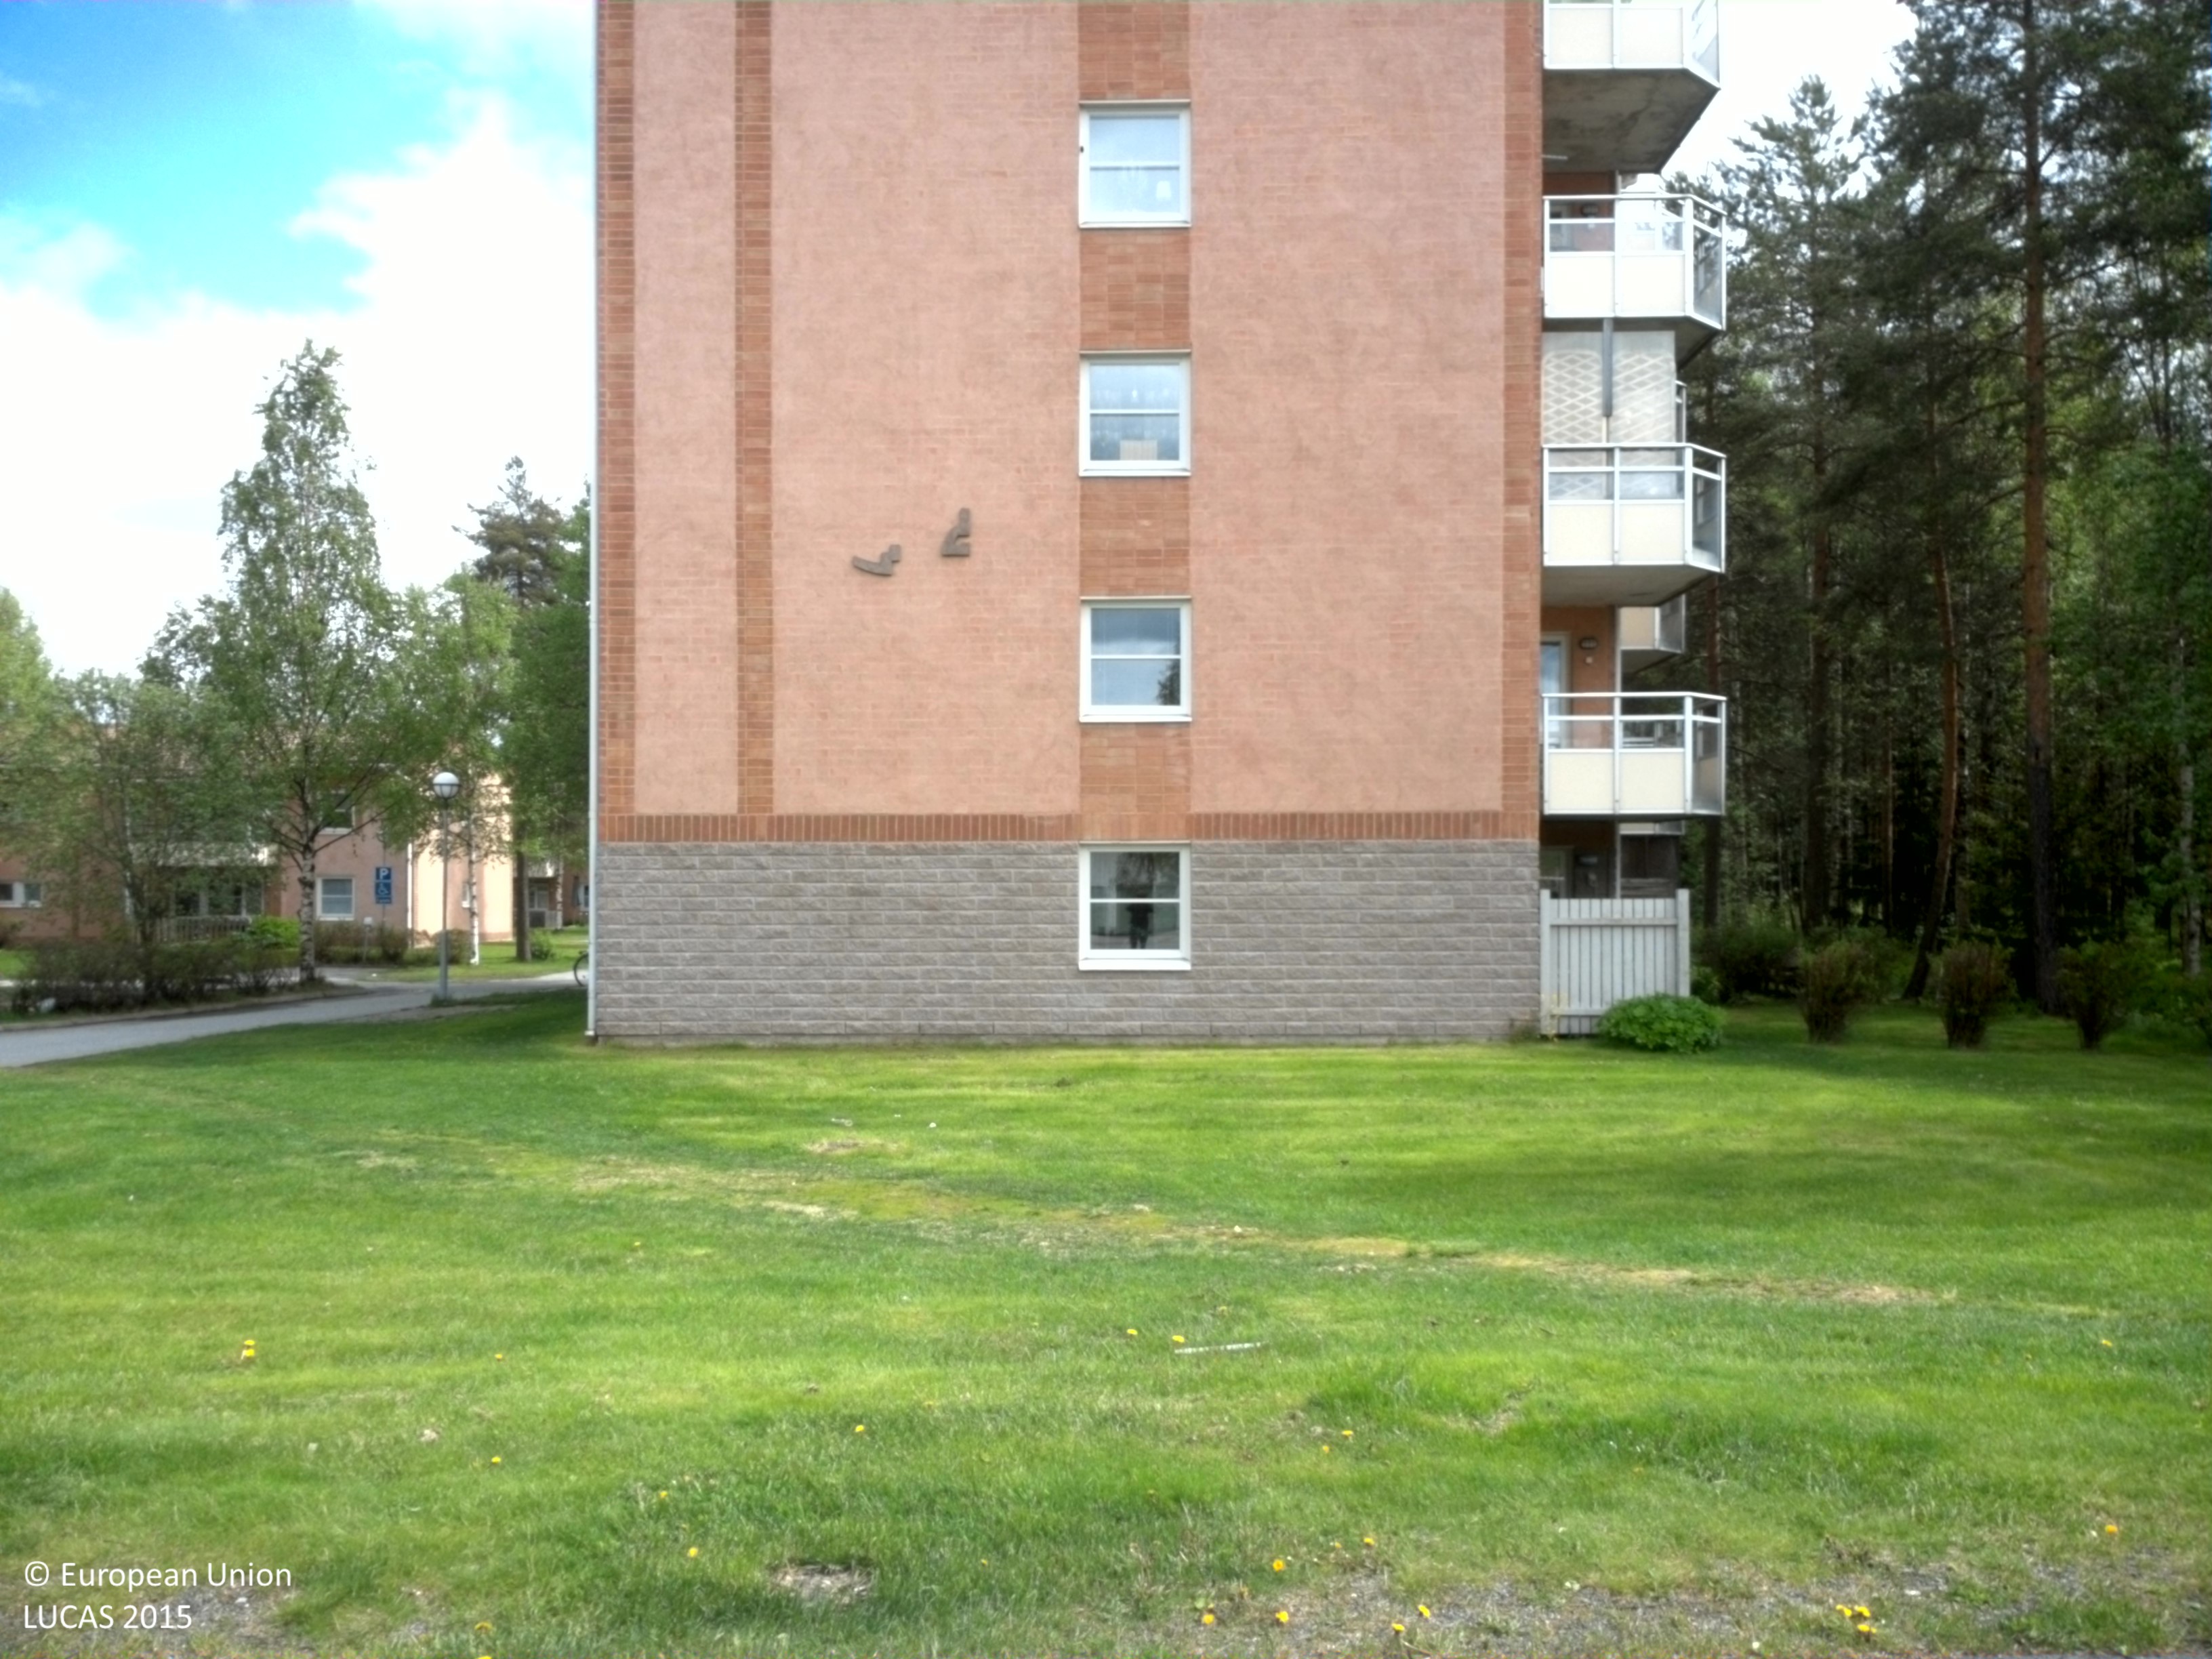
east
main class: Woodland
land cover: Broadleaved woodland
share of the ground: > 75 %
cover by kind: herbaceous plants 70 %, broadleaved forest trees 30 %
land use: Amenities, museums, leisure
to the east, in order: Broadleaved woodland; Artificial constructions in urban areas
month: June
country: SE
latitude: 63.8594
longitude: 20.3370
